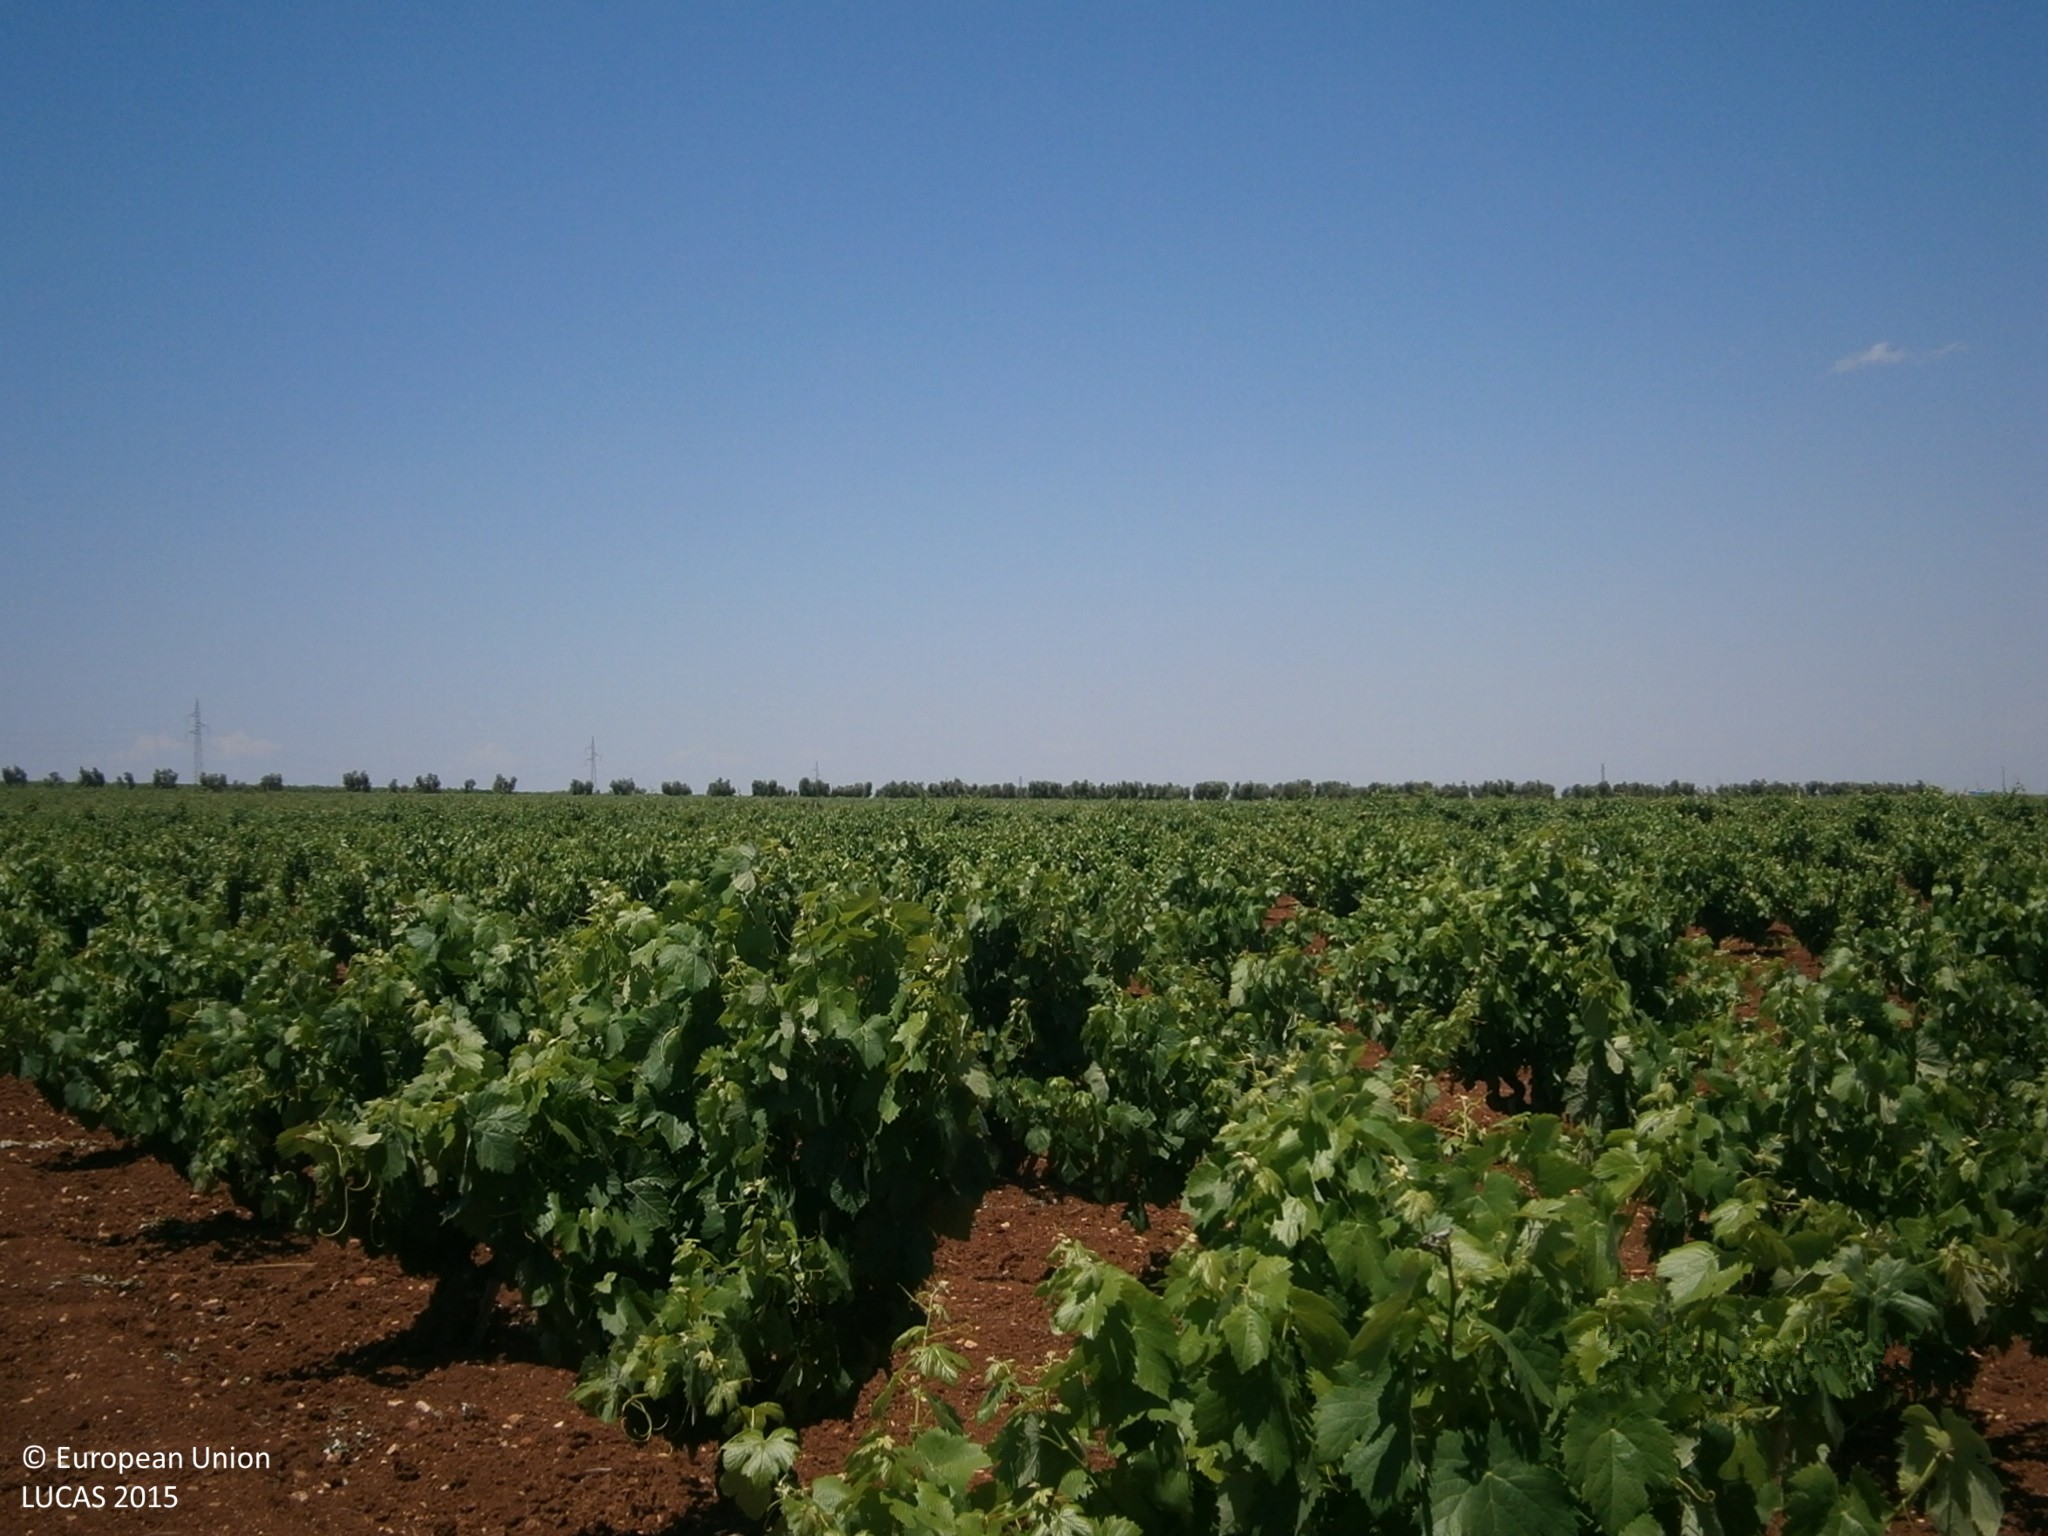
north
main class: Cropland
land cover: Vineyards
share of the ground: 25 - 50 %
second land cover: Other bare soil
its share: > 75 %
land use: Agriculture (excluding fallow land and kitchen gardens)
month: June
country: ES
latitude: 38.6407
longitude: -6.3791
